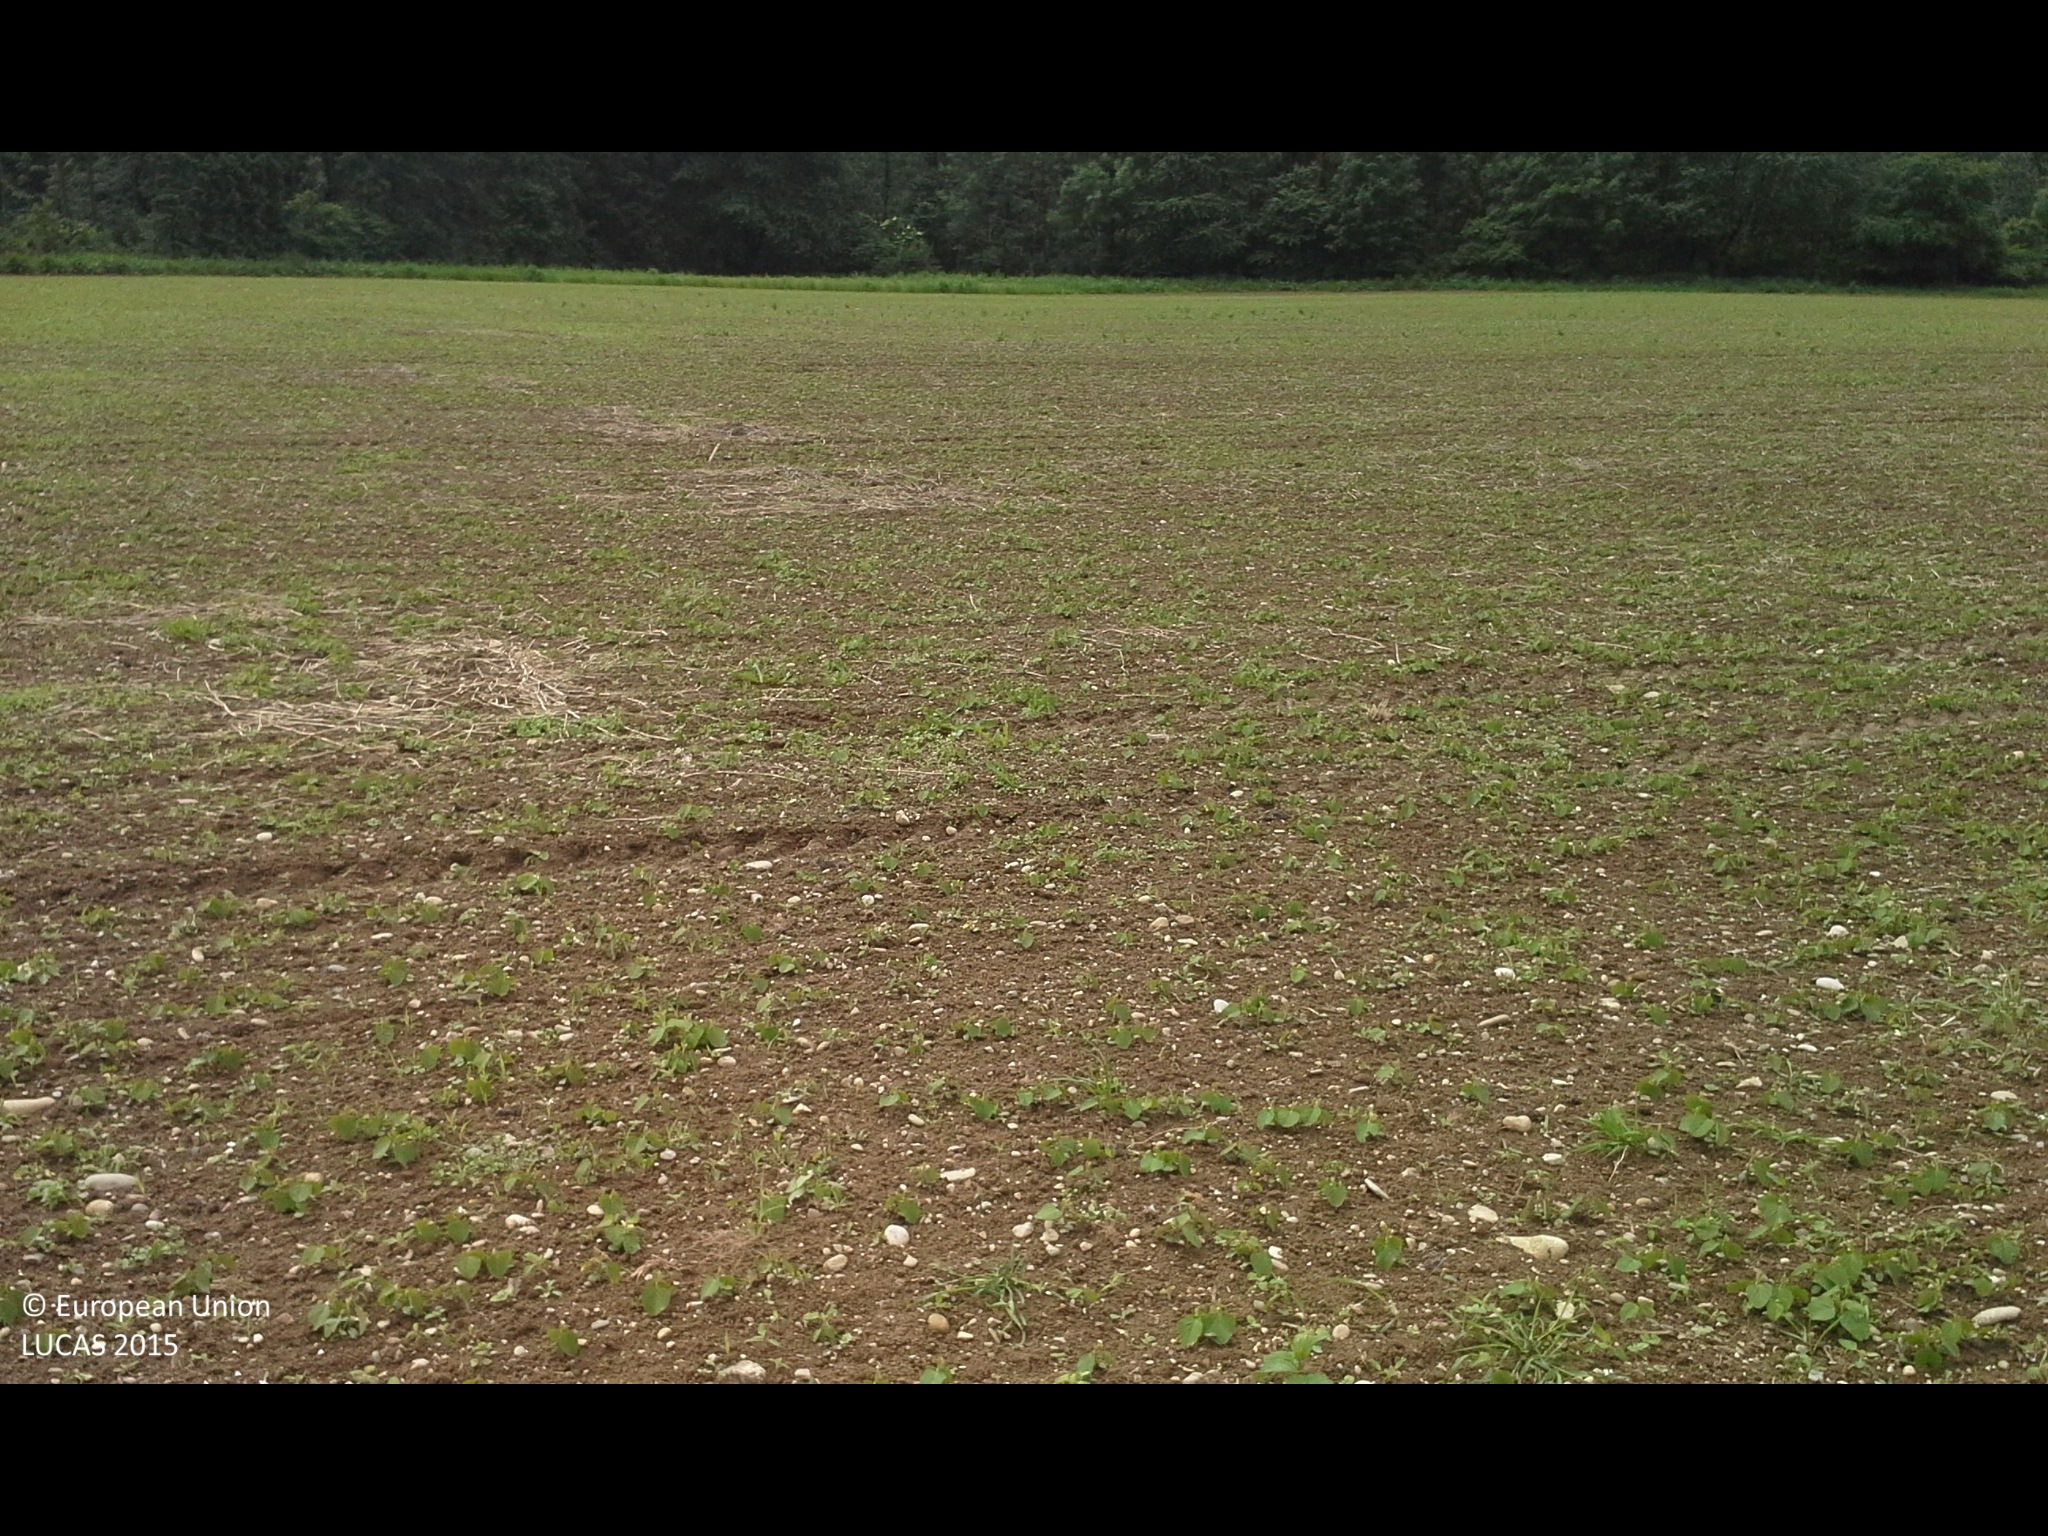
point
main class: Cropland
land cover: Soya
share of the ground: 10 - 25 %
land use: Agriculture (excluding fallow land and kitchen gardens)
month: May
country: AT
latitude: 48.1676
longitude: 14.5047
